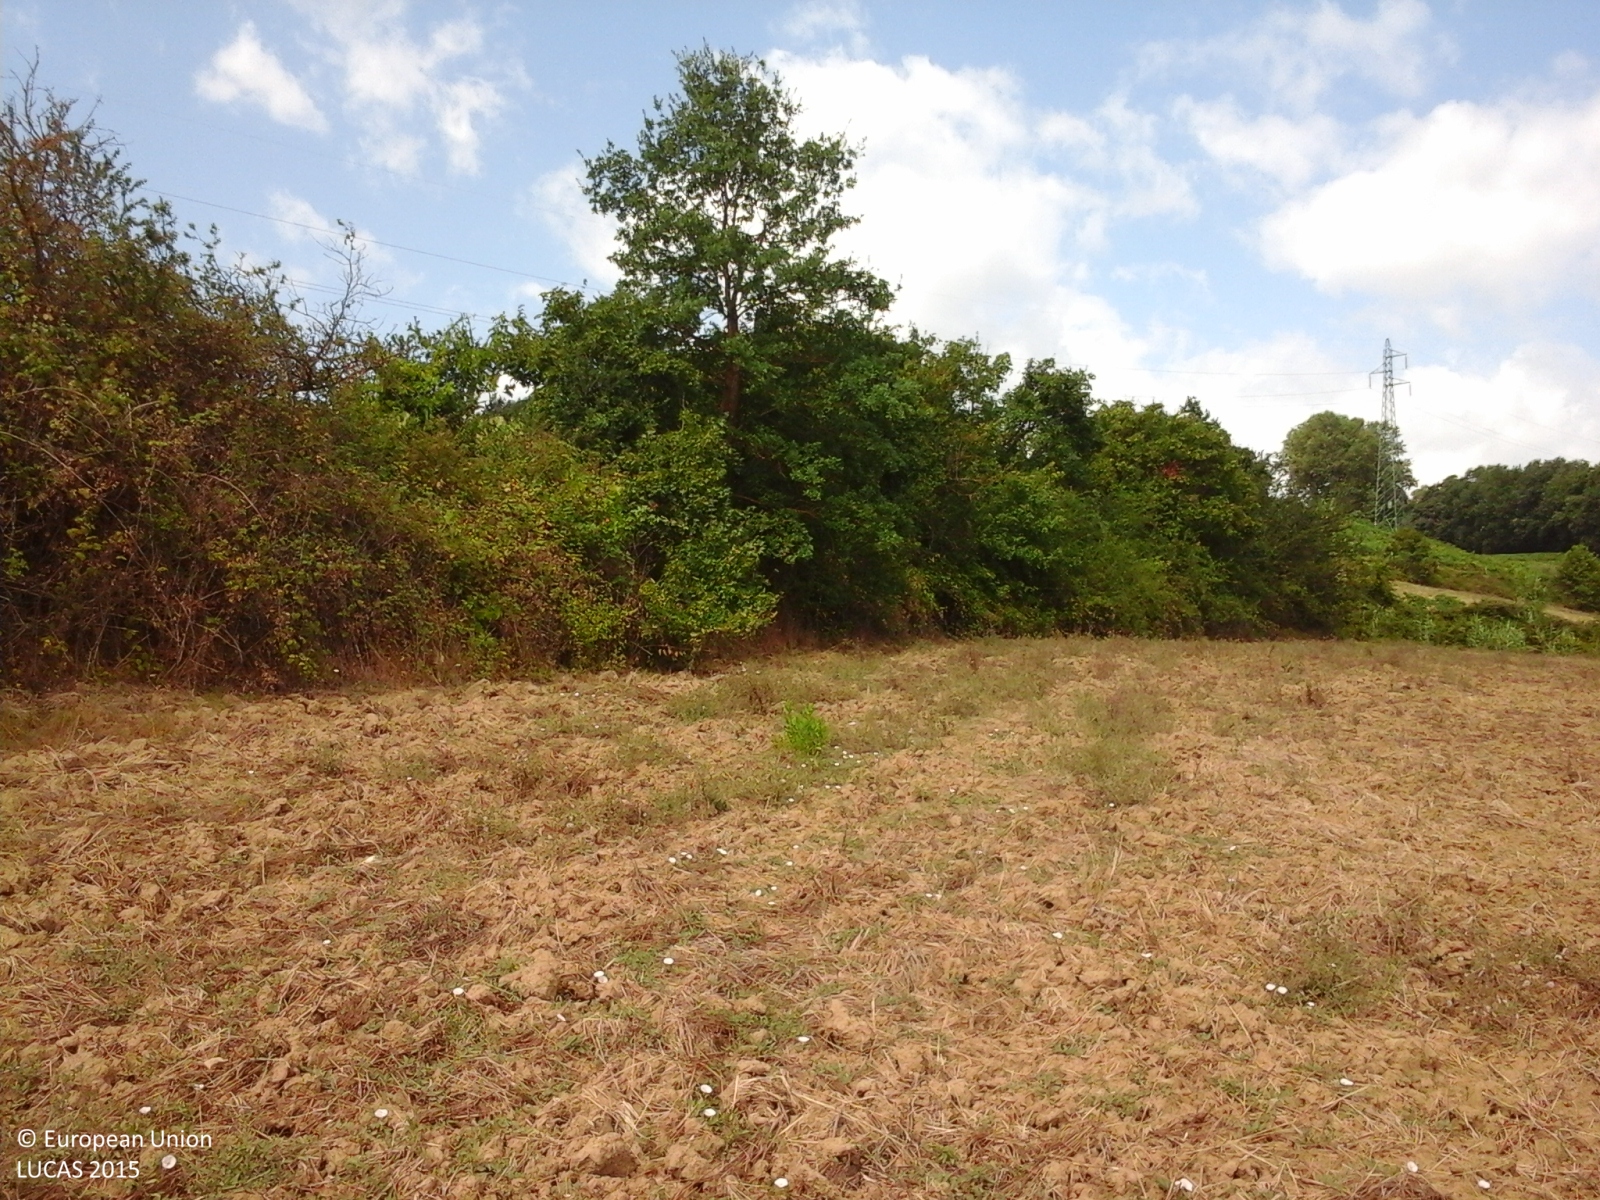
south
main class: Grassland
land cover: Grassland without tree/shrub cover
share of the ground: > 75 %
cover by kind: herbaceous plants 100 %
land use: Agriculture (excluding fallow land and kitchen gardens)
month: July
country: IT
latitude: 43.5150
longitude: 11.0732
